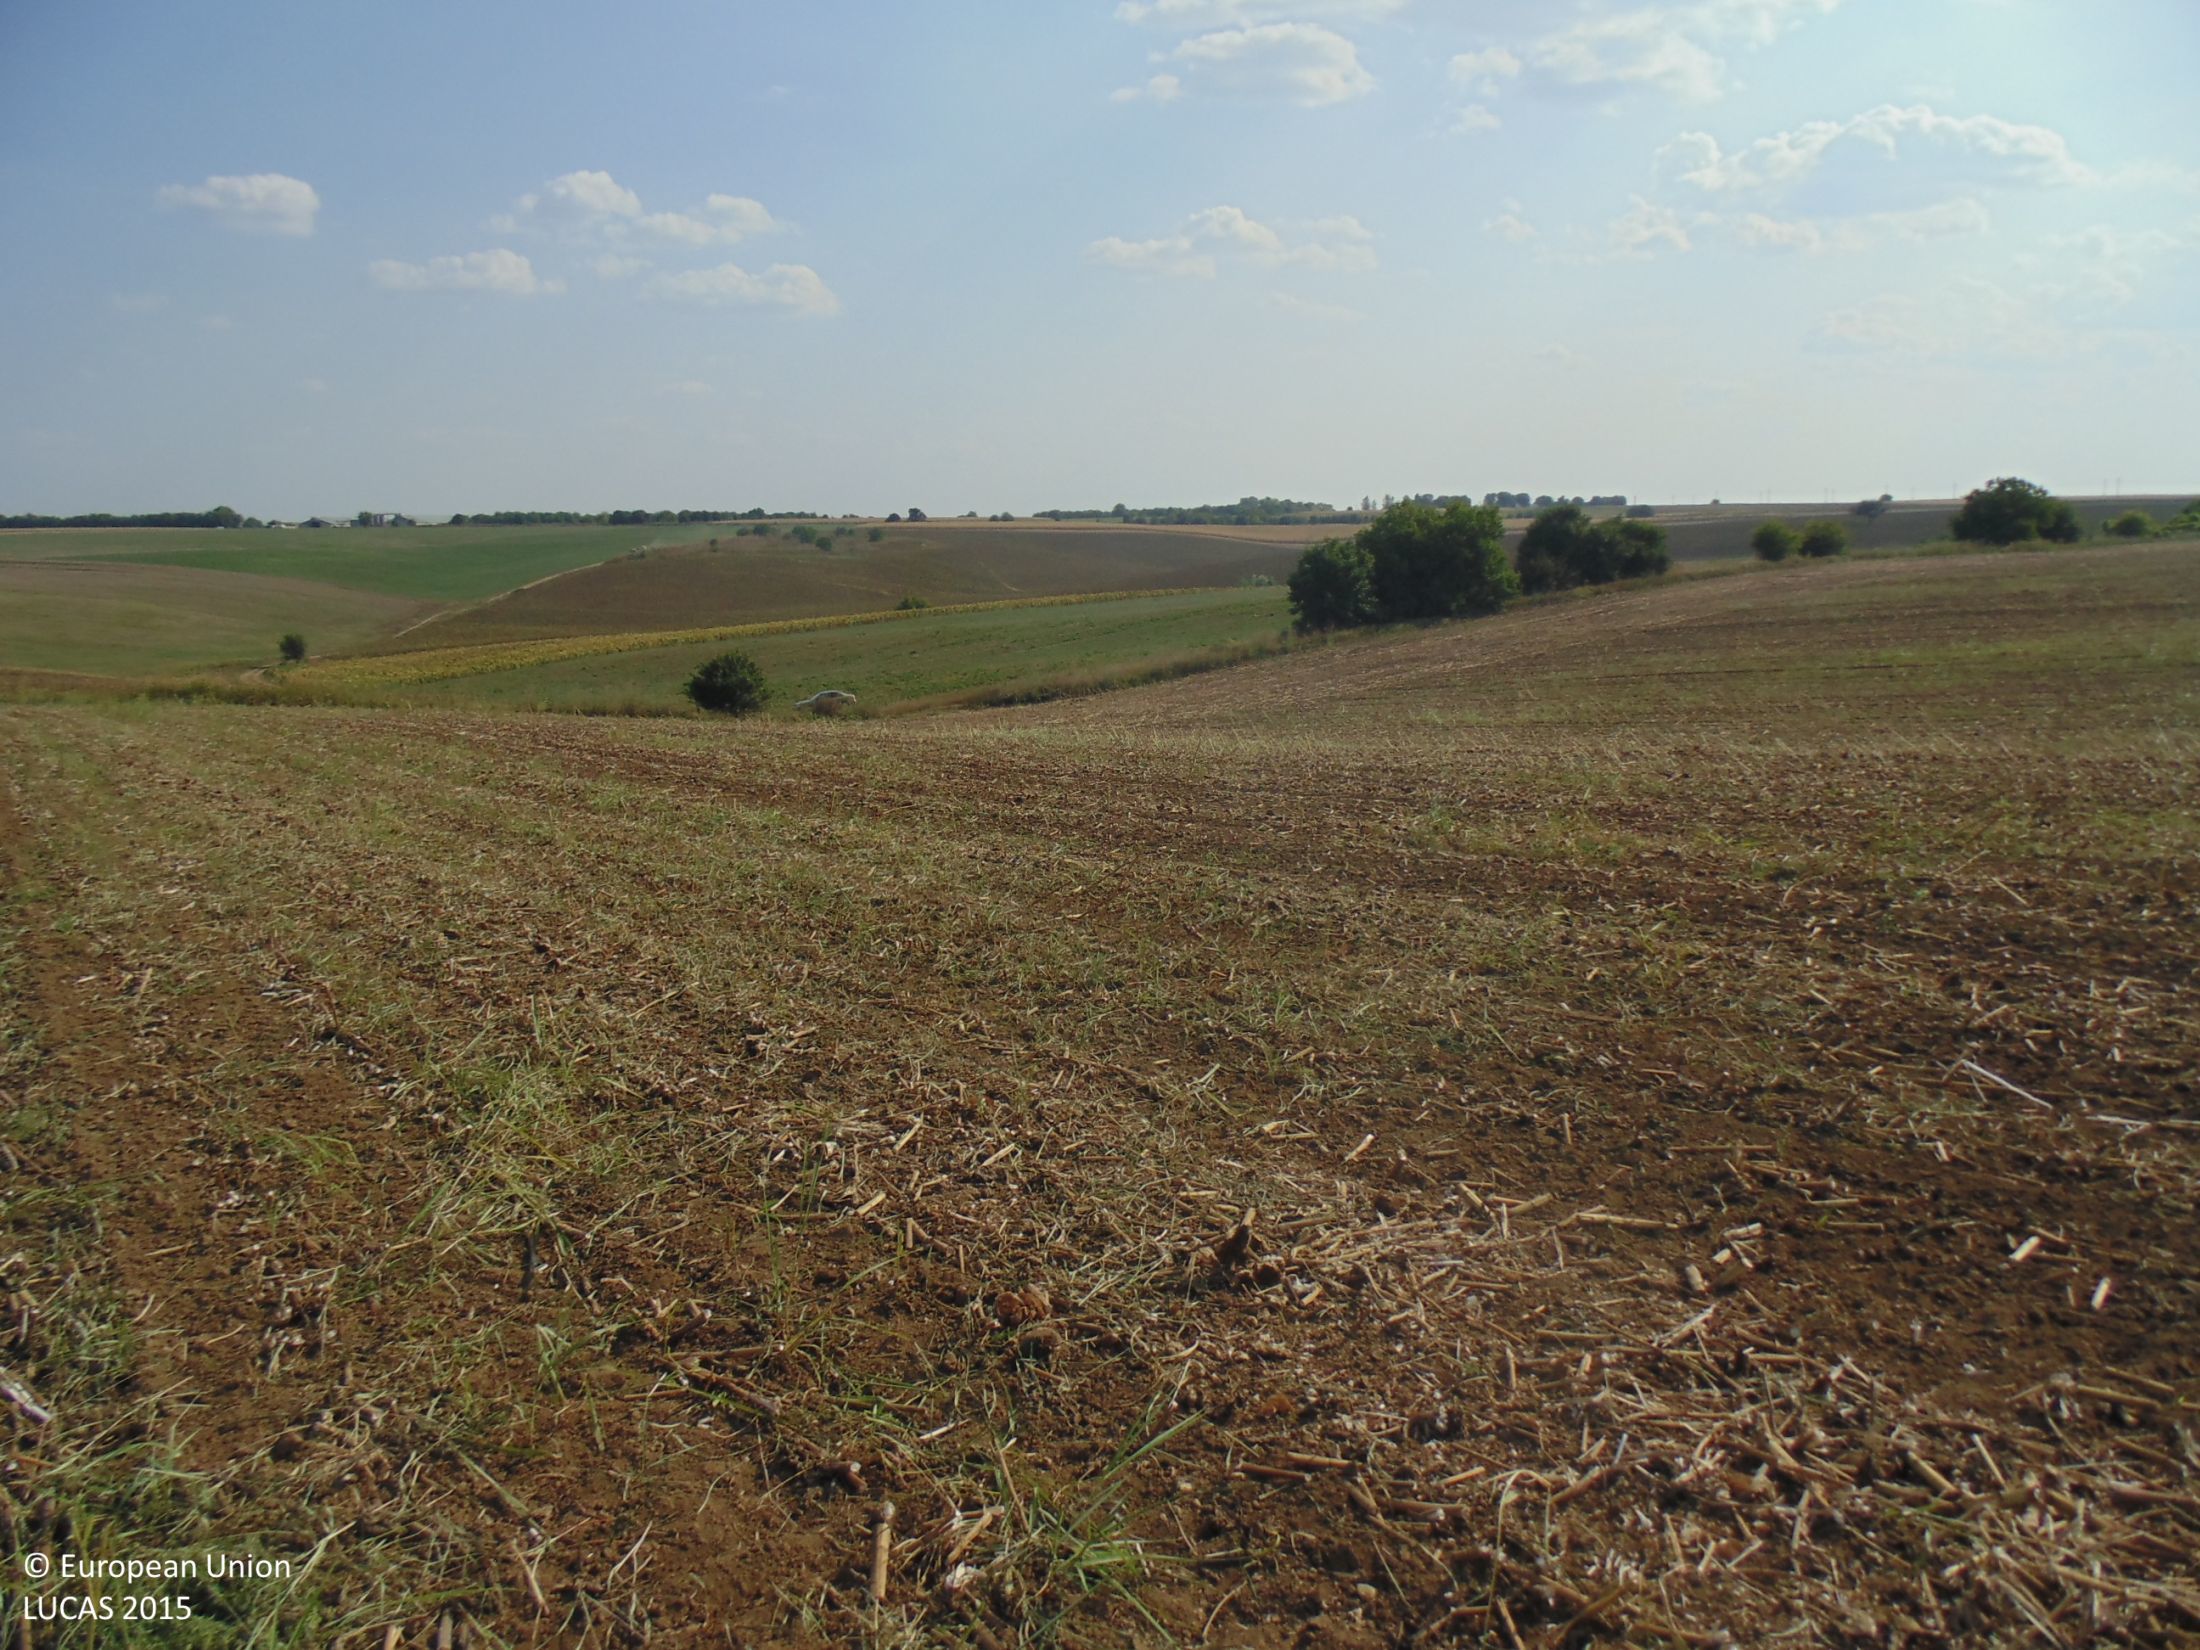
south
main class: Cropland
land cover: Sunflower
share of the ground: < 10 %
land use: Agriculture (excluding fallow land and kitchen gardens)
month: August
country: BG
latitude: 43.9579
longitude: 27.2654
